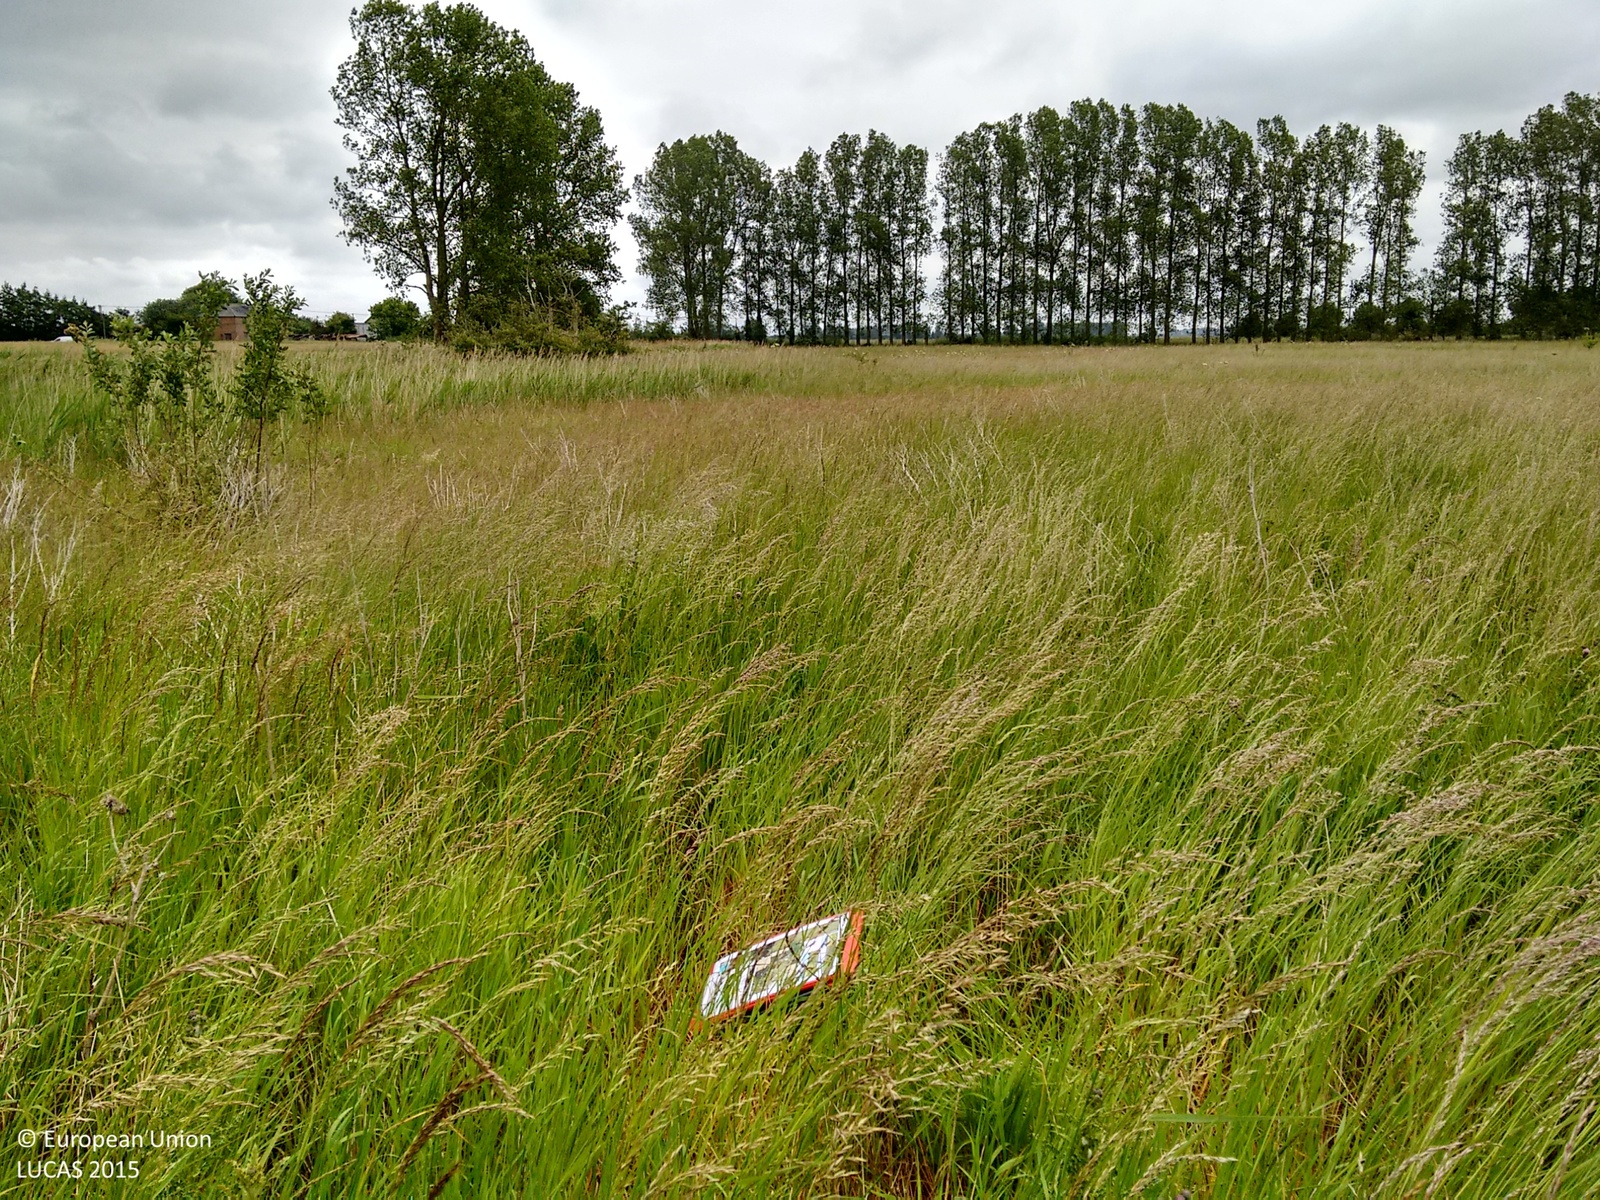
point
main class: Grassland
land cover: Grassland without tree/shrub cover
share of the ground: > 75 %
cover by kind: herbaceous plants 100 %
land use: Sport
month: June
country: GB
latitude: 52.7351
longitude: 0.2399
